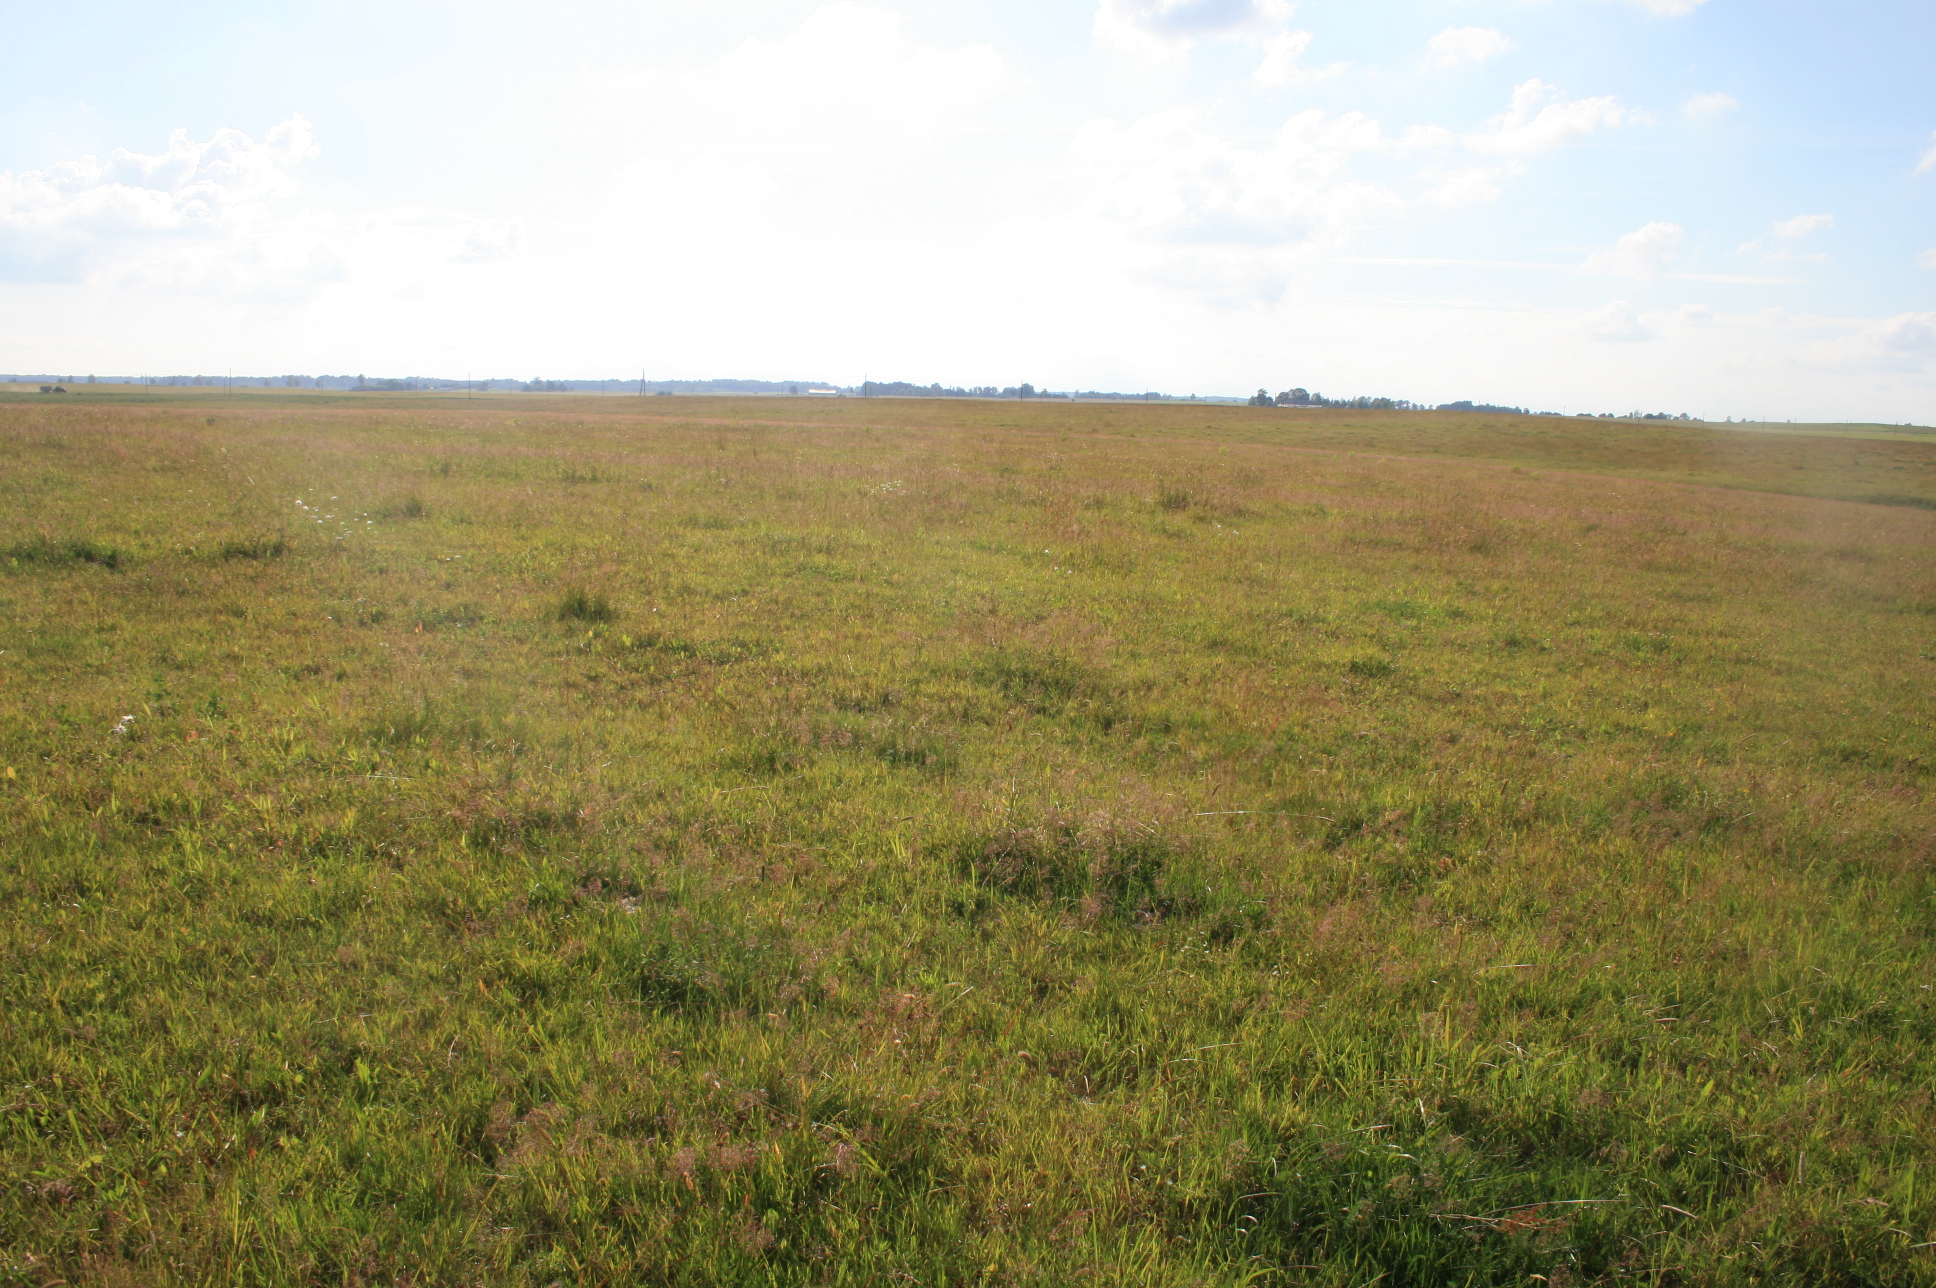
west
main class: Grassland
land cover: Grassland without tree/shrub cover
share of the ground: > 75 %
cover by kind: herbaceous plants 100 %
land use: Agriculture (excluding fallow land and kitchen gardens)
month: June
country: LT
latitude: 55.2056
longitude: 21.9802
